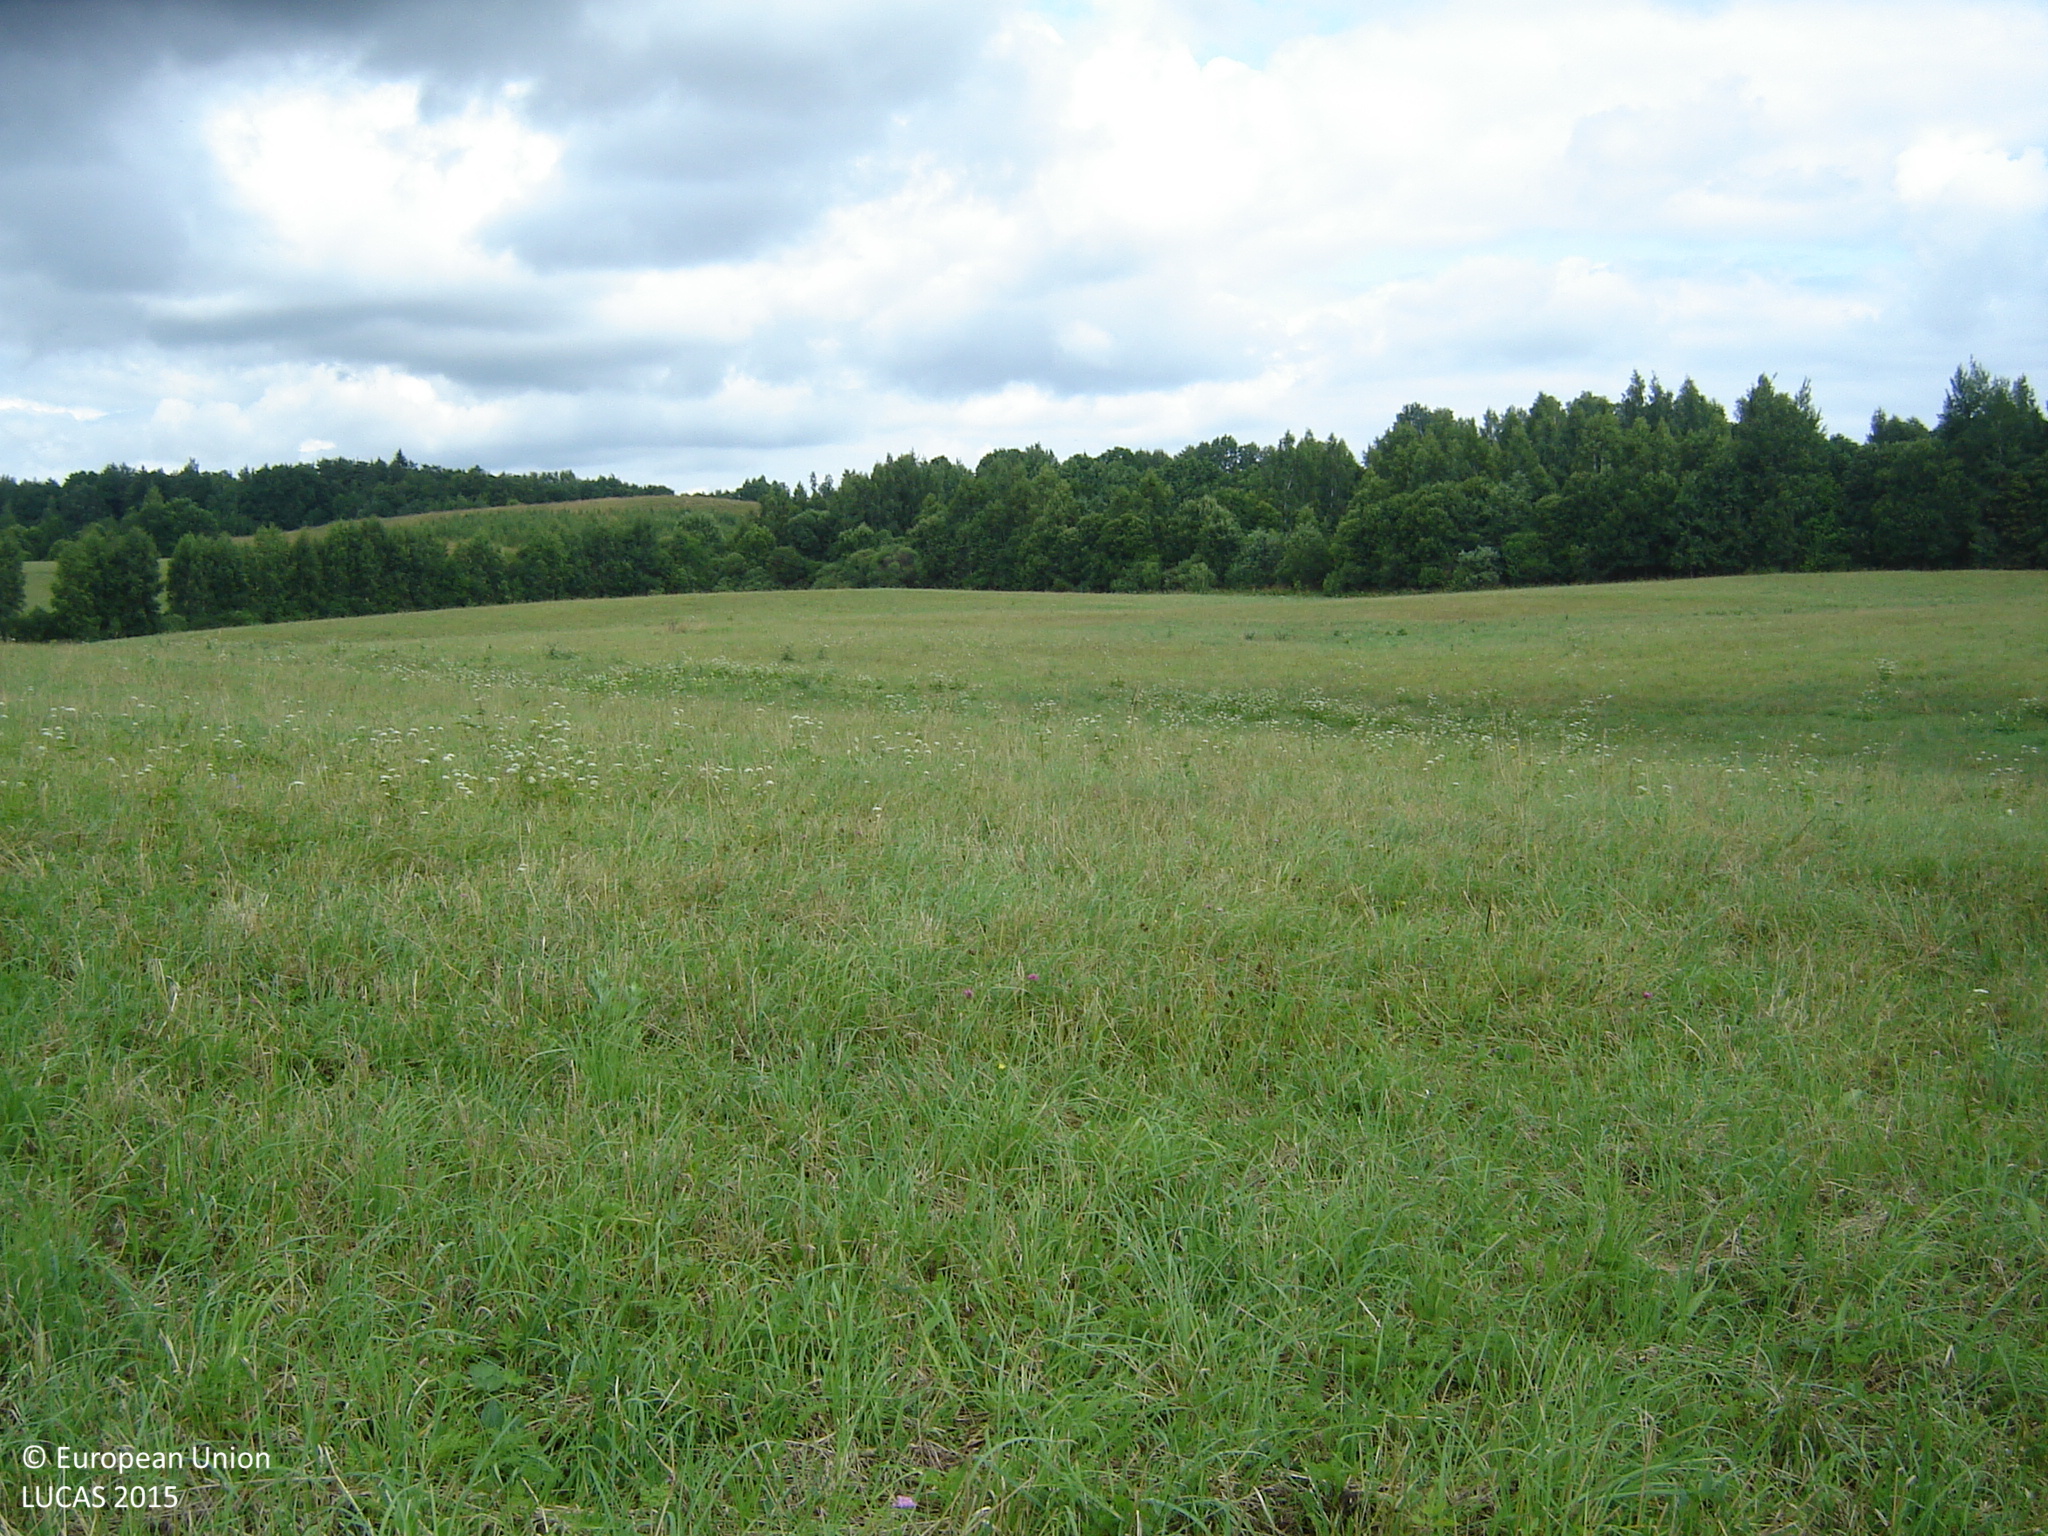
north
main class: Grassland
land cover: Grassland without tree/shrub cover
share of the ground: > 75 %
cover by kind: herbaceous plants 100 %
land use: Agriculture (excluding fallow land and kitchen gardens)
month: July
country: LT
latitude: 55.3992
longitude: 25.2292
